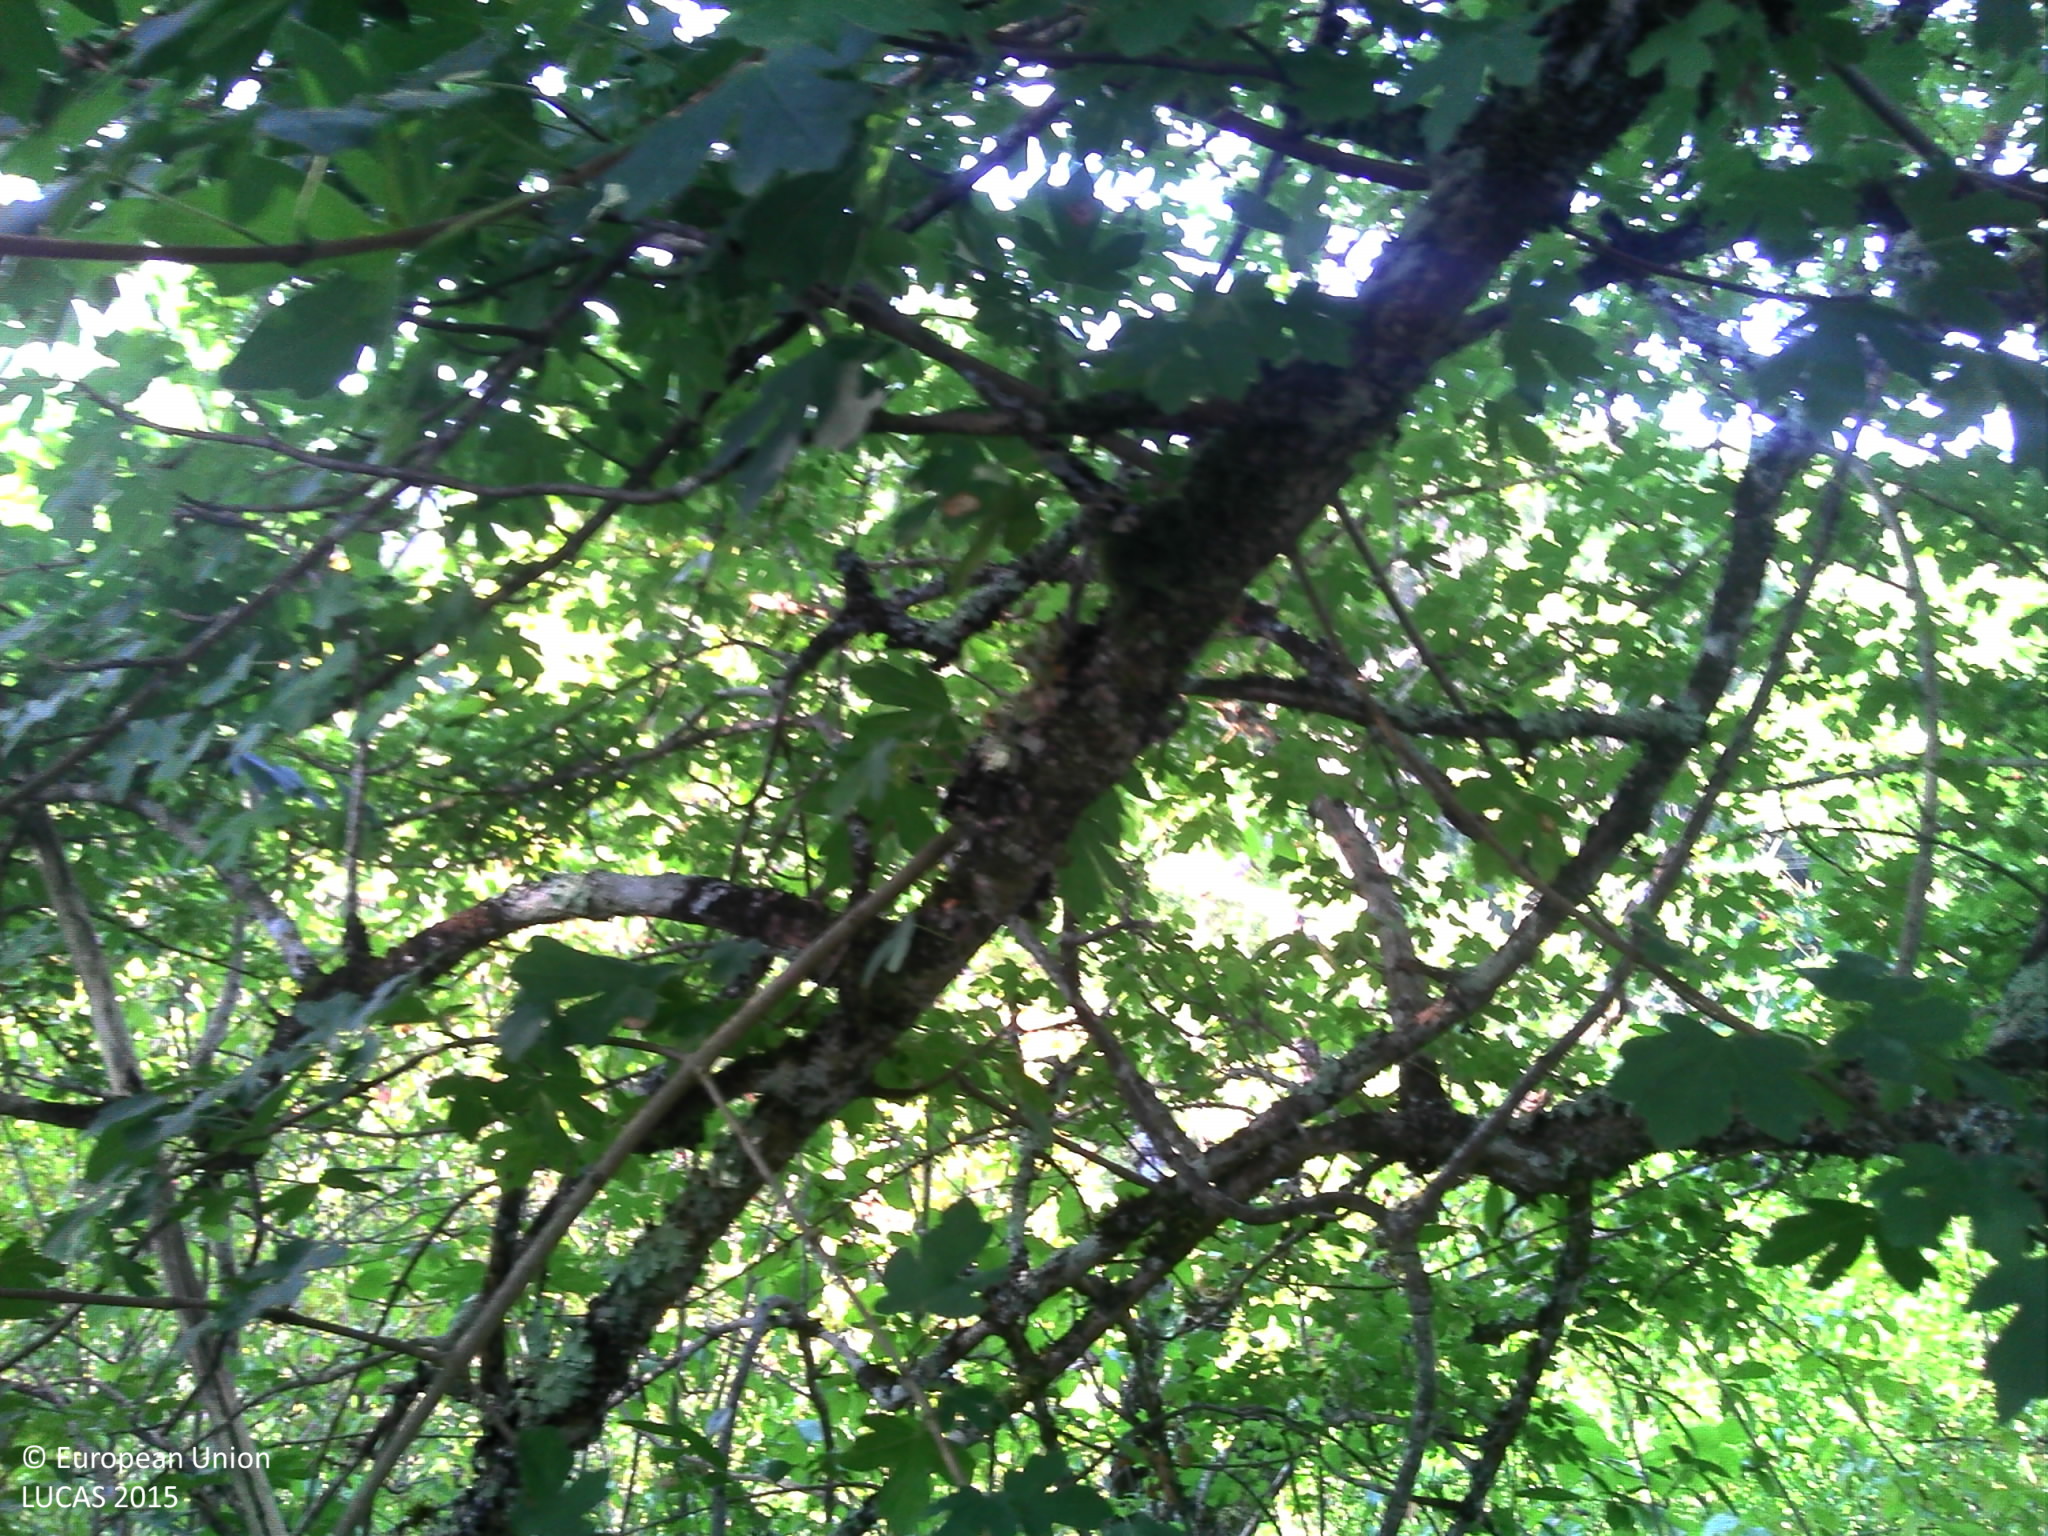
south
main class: Woodland
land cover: Broadleaved woodland
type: mesophytic deciduous forest
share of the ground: > 75 %
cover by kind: broadleaved forest trees 80 %, shrubs 10 %, herbaceous plants 10 %
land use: Forestry
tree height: > 5 m
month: August
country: FR
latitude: 47.1663
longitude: 4.8688
